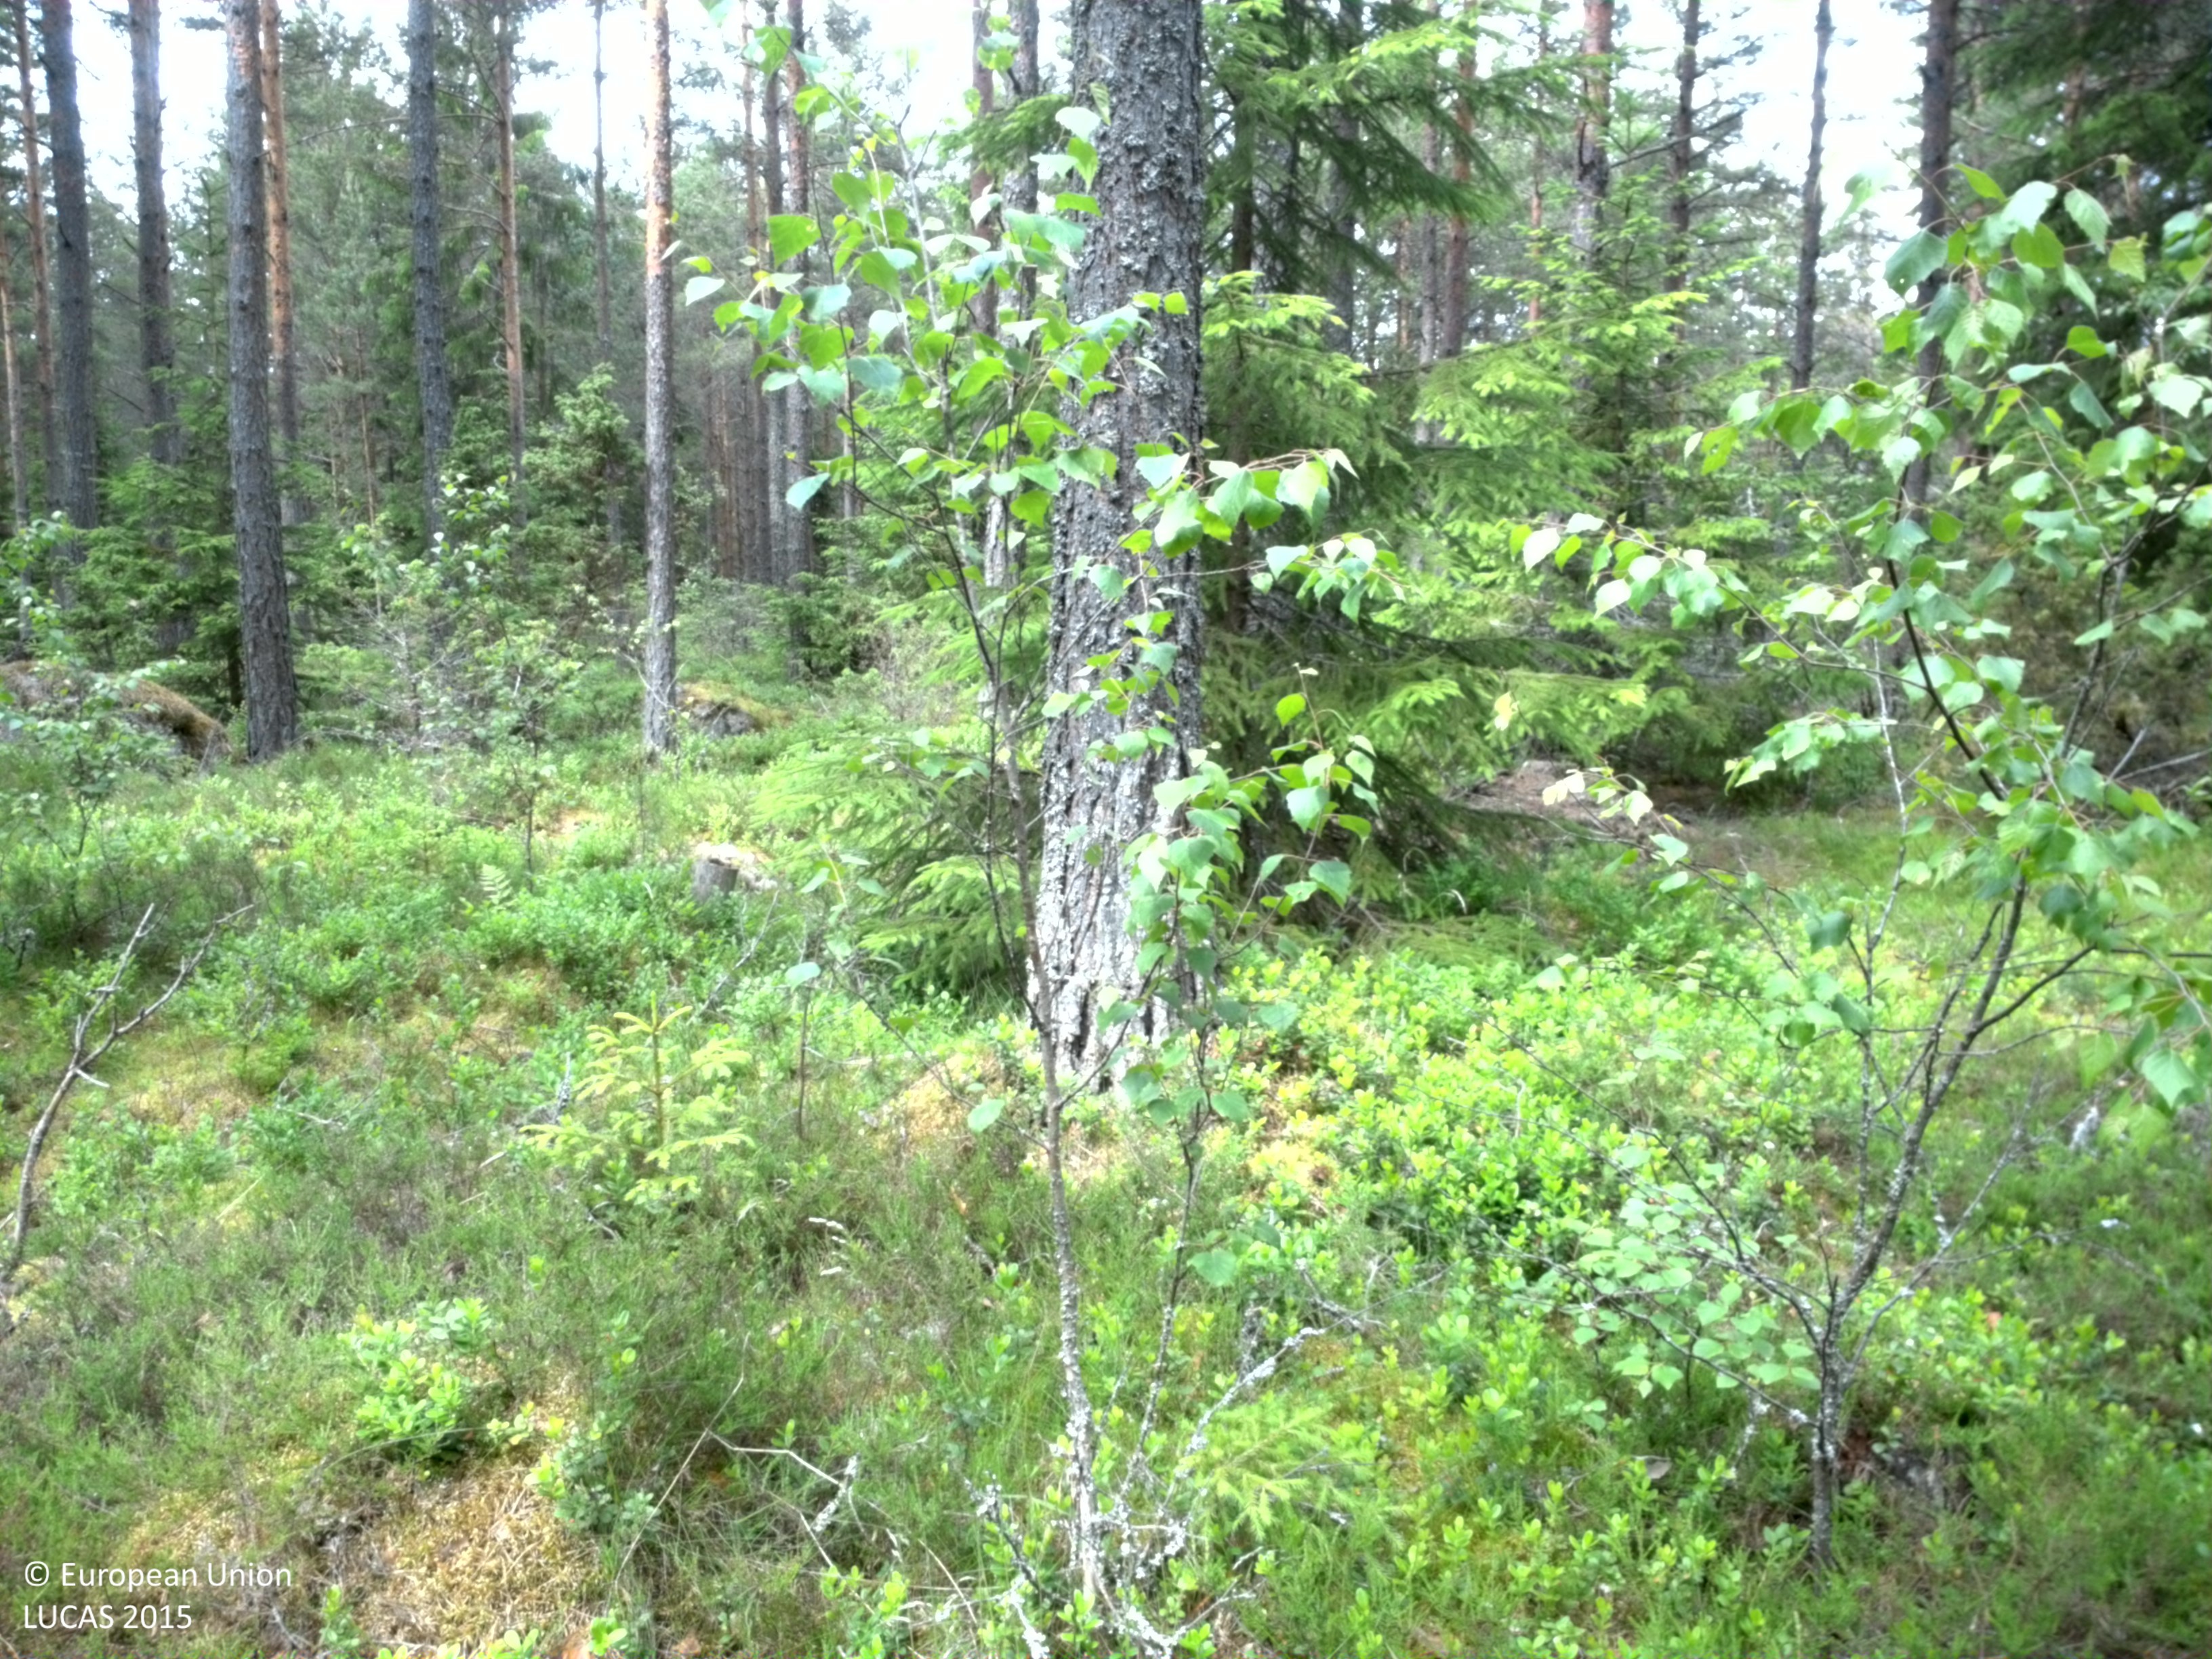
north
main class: Woodland
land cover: Pine dominated coniferous woodland
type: boreal forest
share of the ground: 10 - 25 %
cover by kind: herbaceous plants 35 %, lichens and mosses 35 %, coniferous forest trees 20 %, broadleaved forest trees 5 %, shrubs 5 %
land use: Forestry
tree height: > 5 m
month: June
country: SE
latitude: 58.7008
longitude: 15.5334
